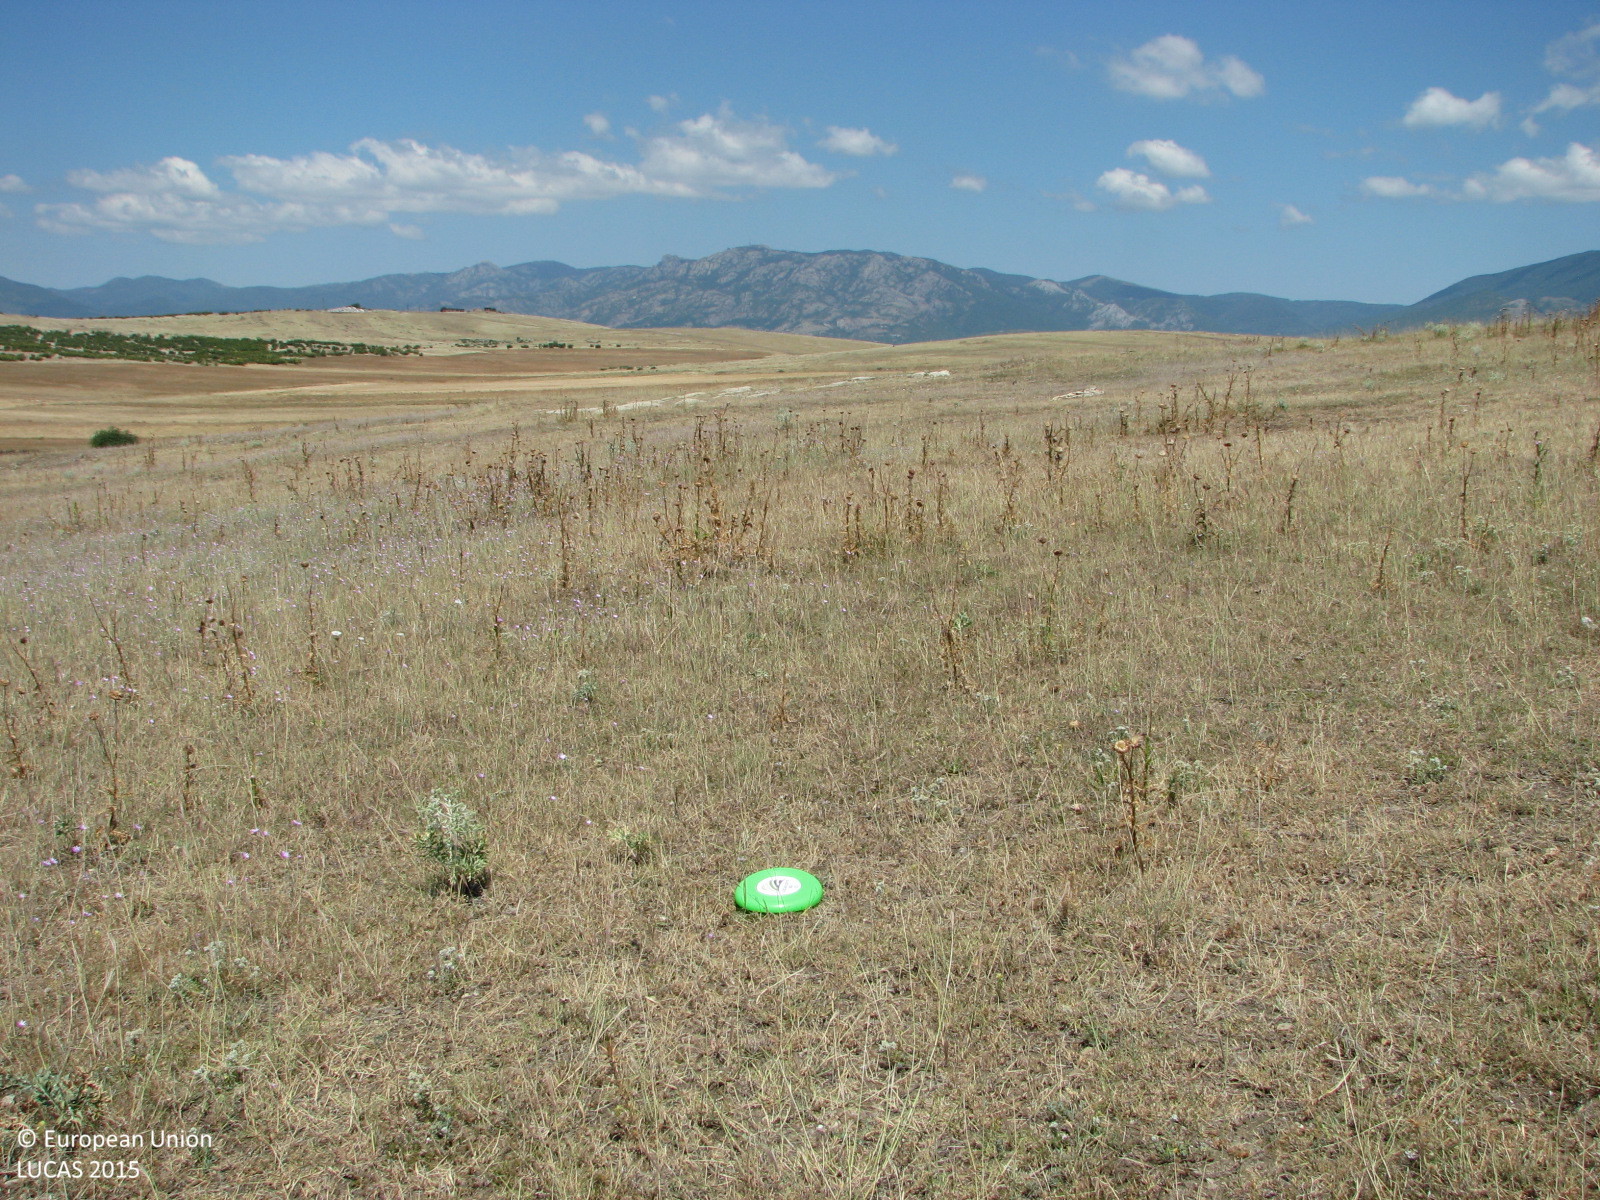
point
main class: Grassland
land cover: Grassland without tree/shrub cover
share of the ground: > 75 %
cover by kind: herbaceous plants 90 %, unconsolidated bare surface 10 %
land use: Semi-natural and natural areas not in use
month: July
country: BG
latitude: 42.6099
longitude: 26.4139
